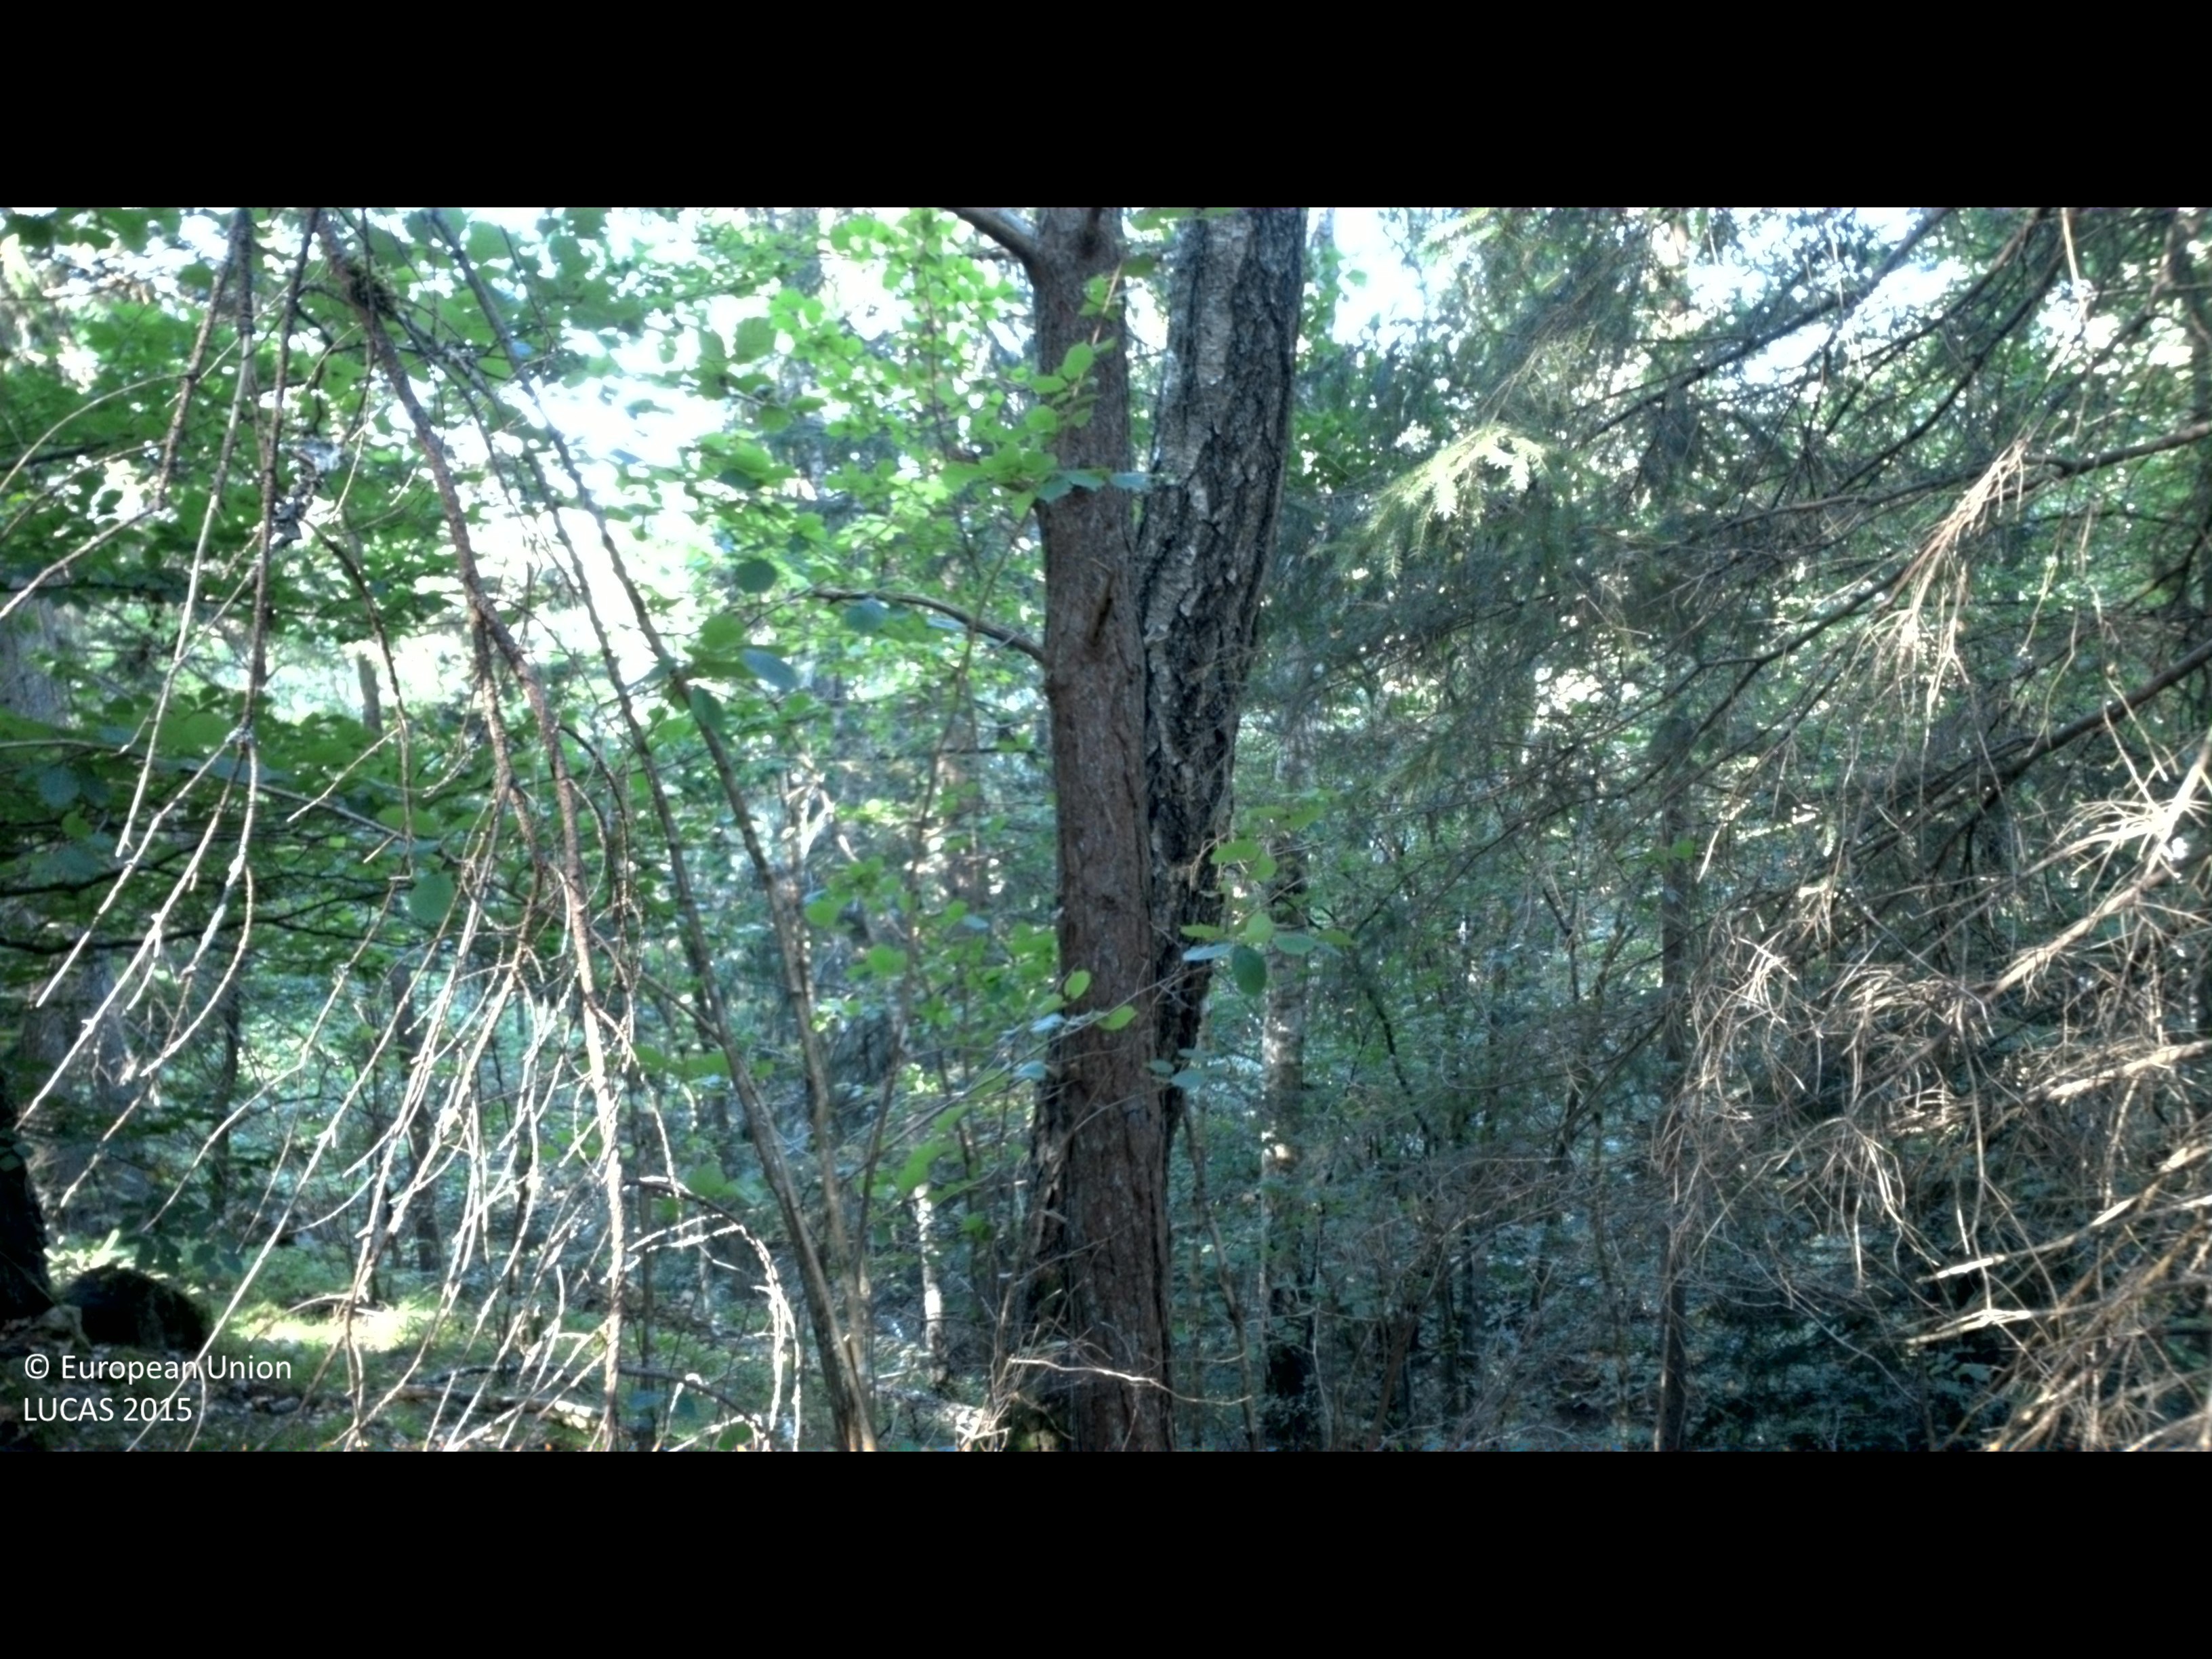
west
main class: Woodland
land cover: Spruce dominated mixed woodland
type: hemiboreal forest and nemoral coniferous forest and mixed broadleaved-coniferous forest
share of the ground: 50 - 75 %
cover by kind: coniferous forest trees 55 %, broadleaved forest trees 20 %, shrubs 10 %, lichens and mosses 10 %, unconsolidated bare surface 5 %
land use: Forestry
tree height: > 5 m
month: August
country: SE
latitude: 56.3236
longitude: 14.5417
